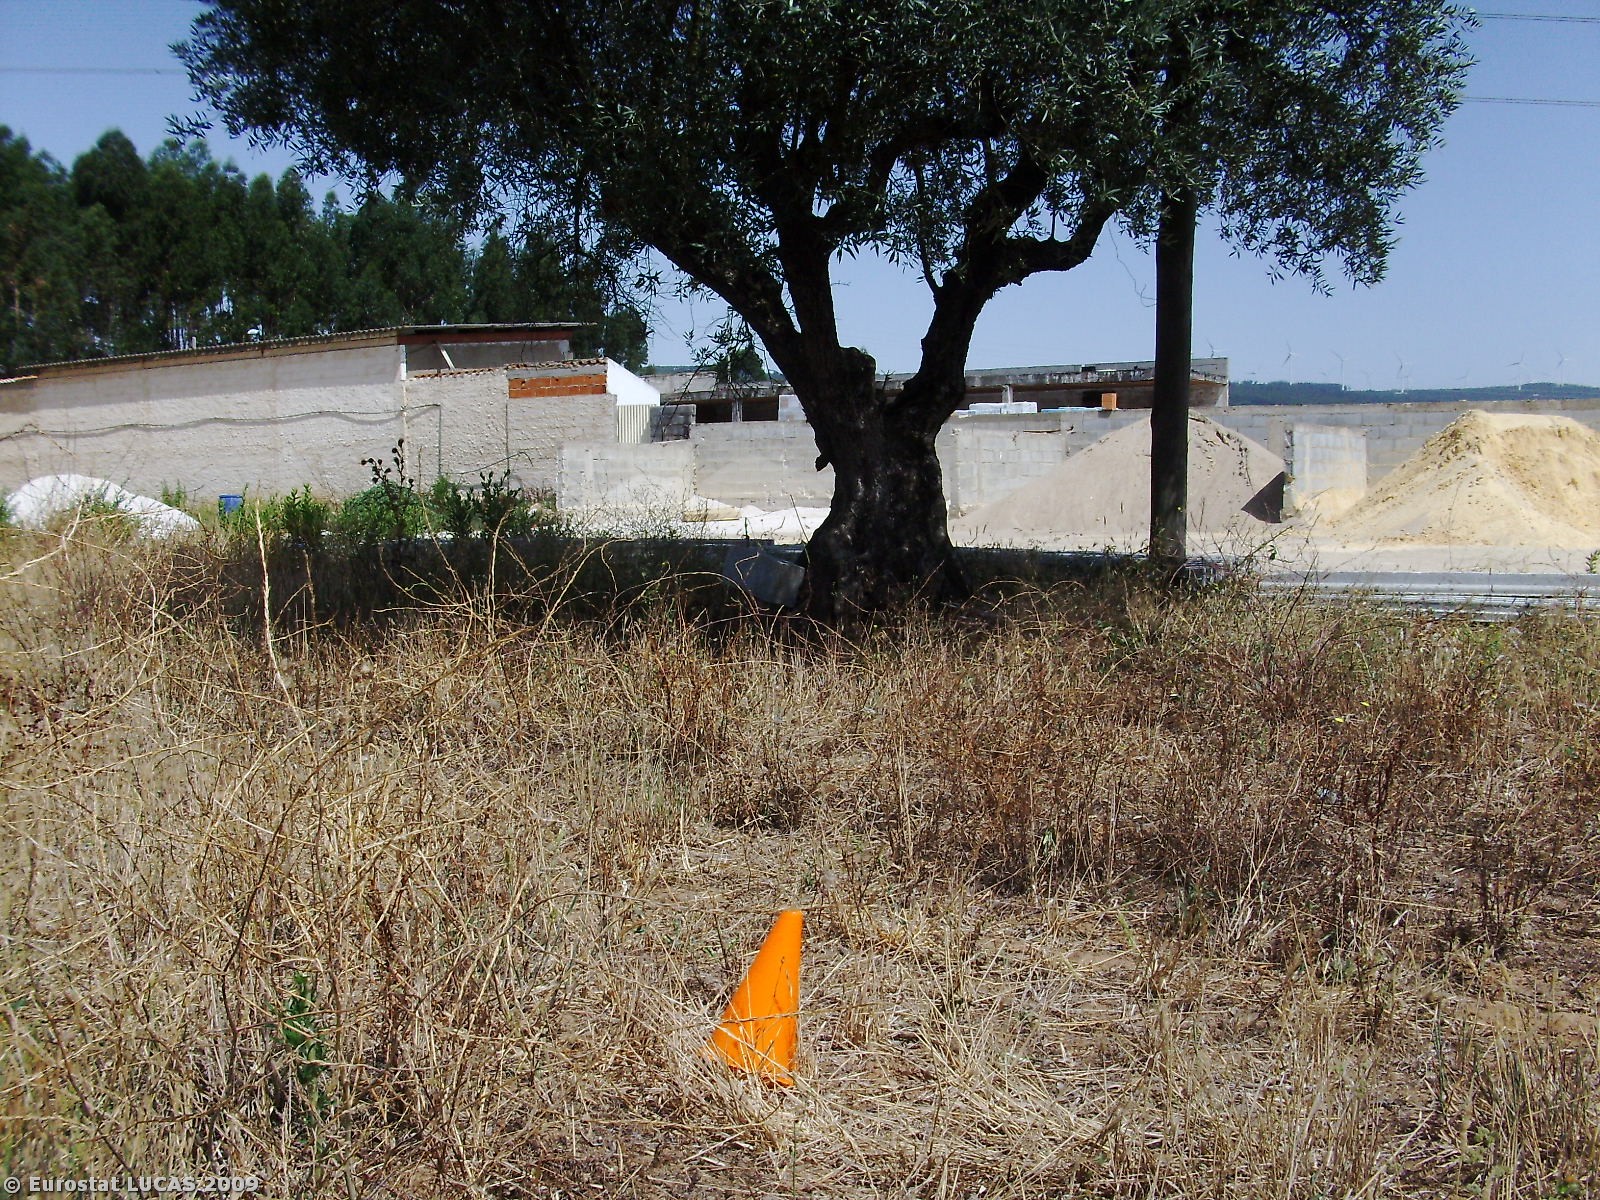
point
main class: Grassland
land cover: Spontaneously vegetated surfaces
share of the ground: > 75 %
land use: Fallow land
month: July
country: PT
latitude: 39.3484
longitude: -8.9381
